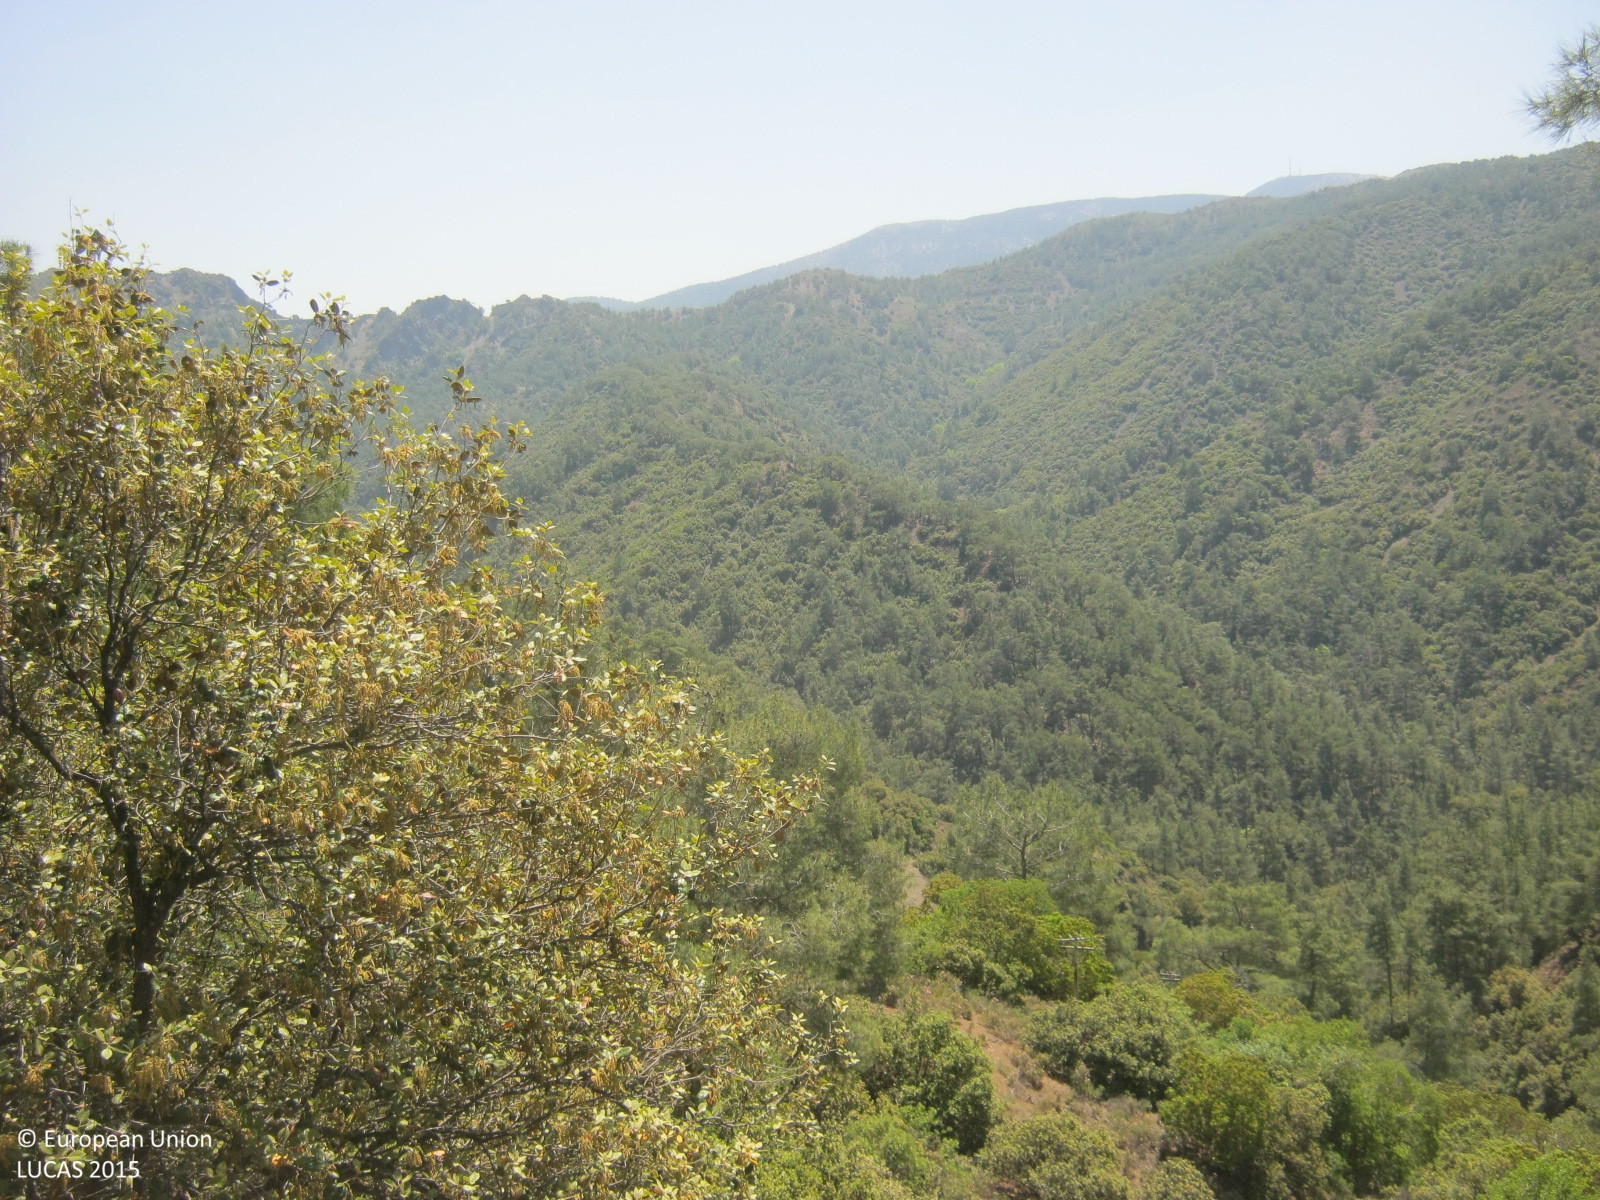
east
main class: Woodland
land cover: Pine dominated mixed woodland
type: coniferous forest of the mediterranean region
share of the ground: > 75 %
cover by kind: coniferous forest trees 75 %, broadleaved forest trees 25 %
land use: Semi-natural and natural areas not in use
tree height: > 5 m
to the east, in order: Pine dominated mixed woodland; Broadleaved woodland; Rivers and streams; Pine dominated mixed woodland
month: May
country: CY
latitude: 34.9799
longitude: 32.7851
